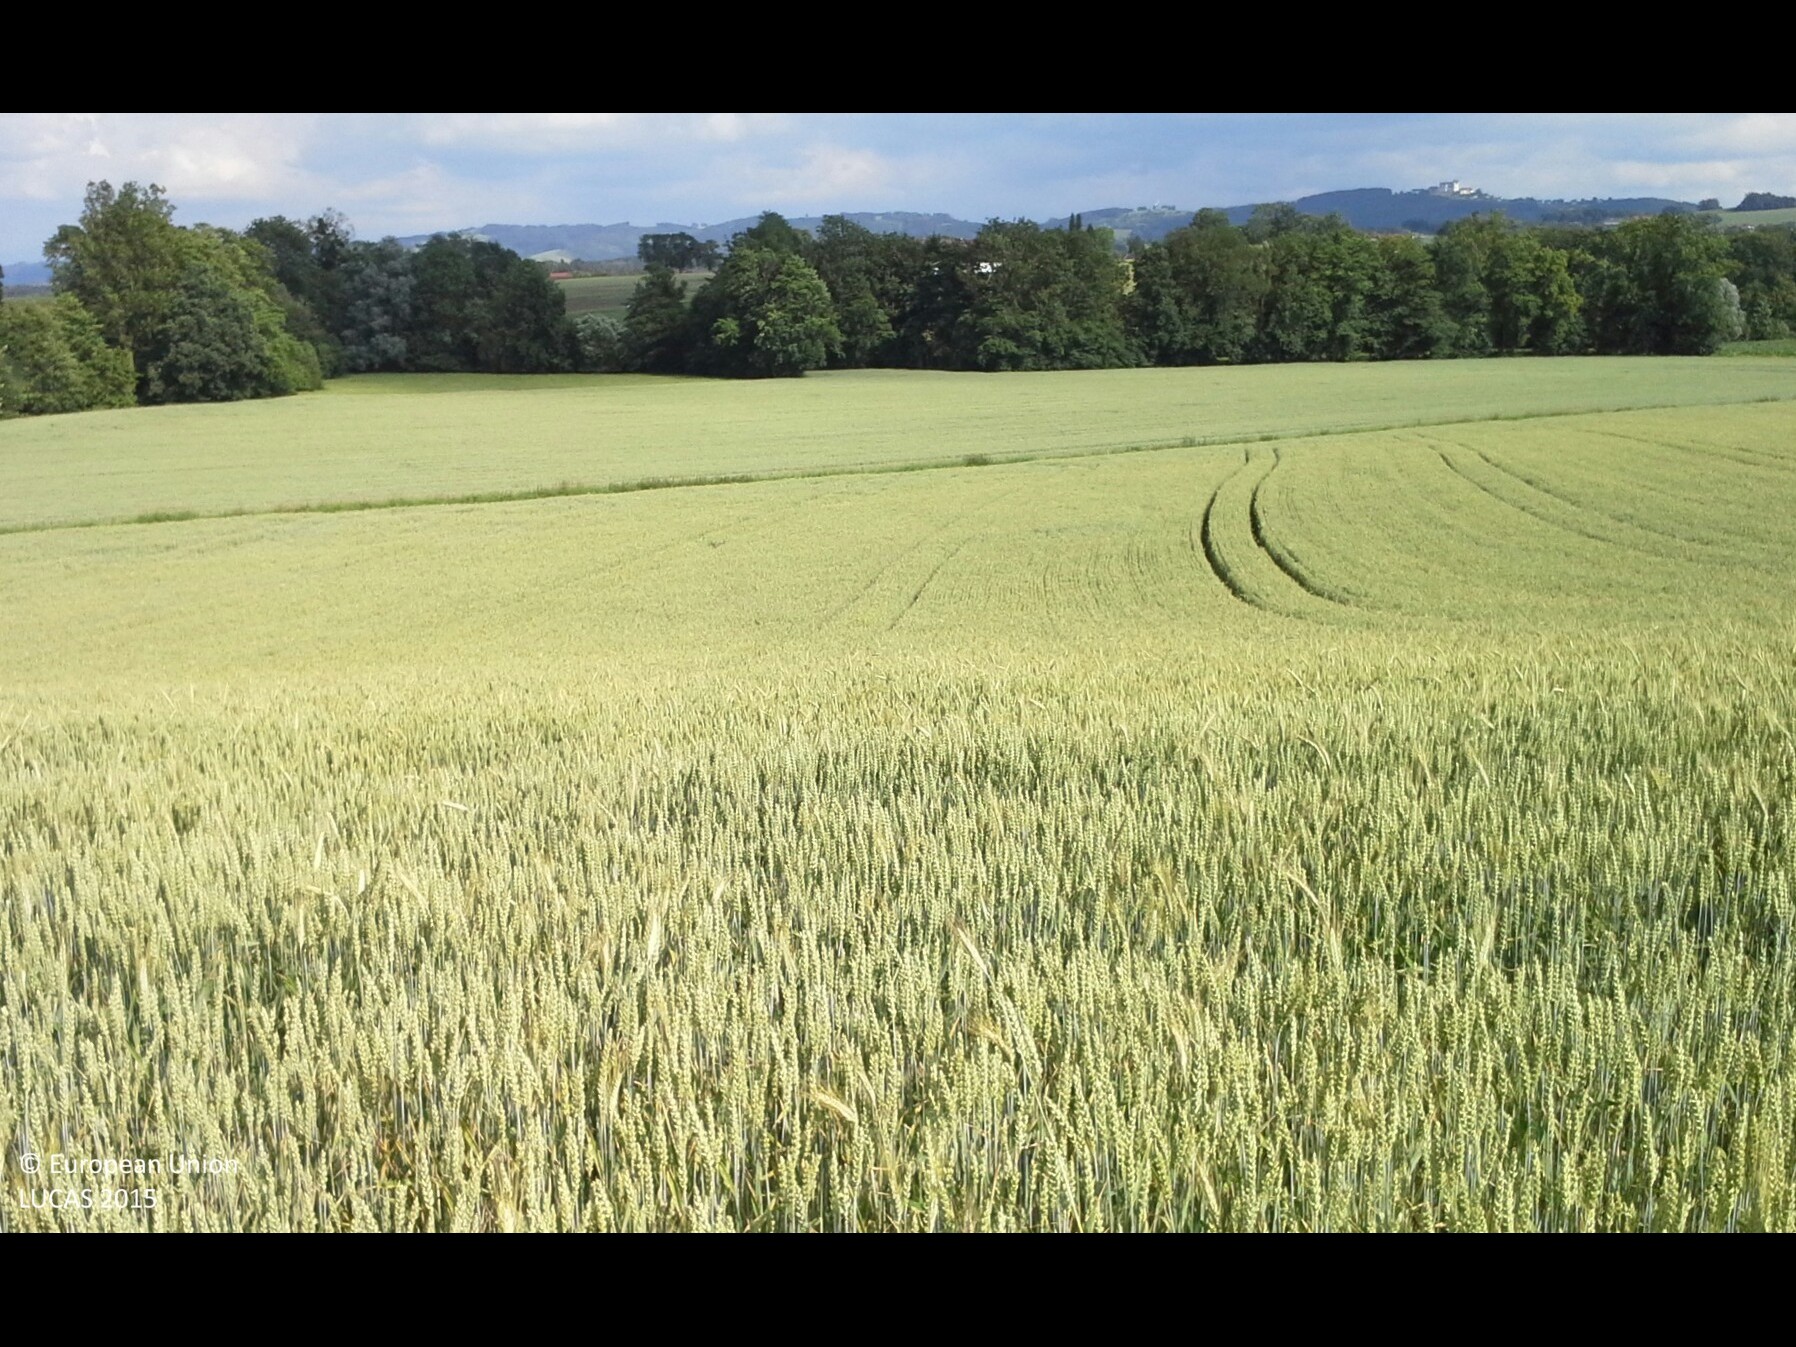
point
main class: Cropland
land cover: Common wheat
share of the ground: > 75 %
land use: Agriculture (excluding fallow land and kitchen gardens)
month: June
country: AT
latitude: 48.0509
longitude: 14.7093
